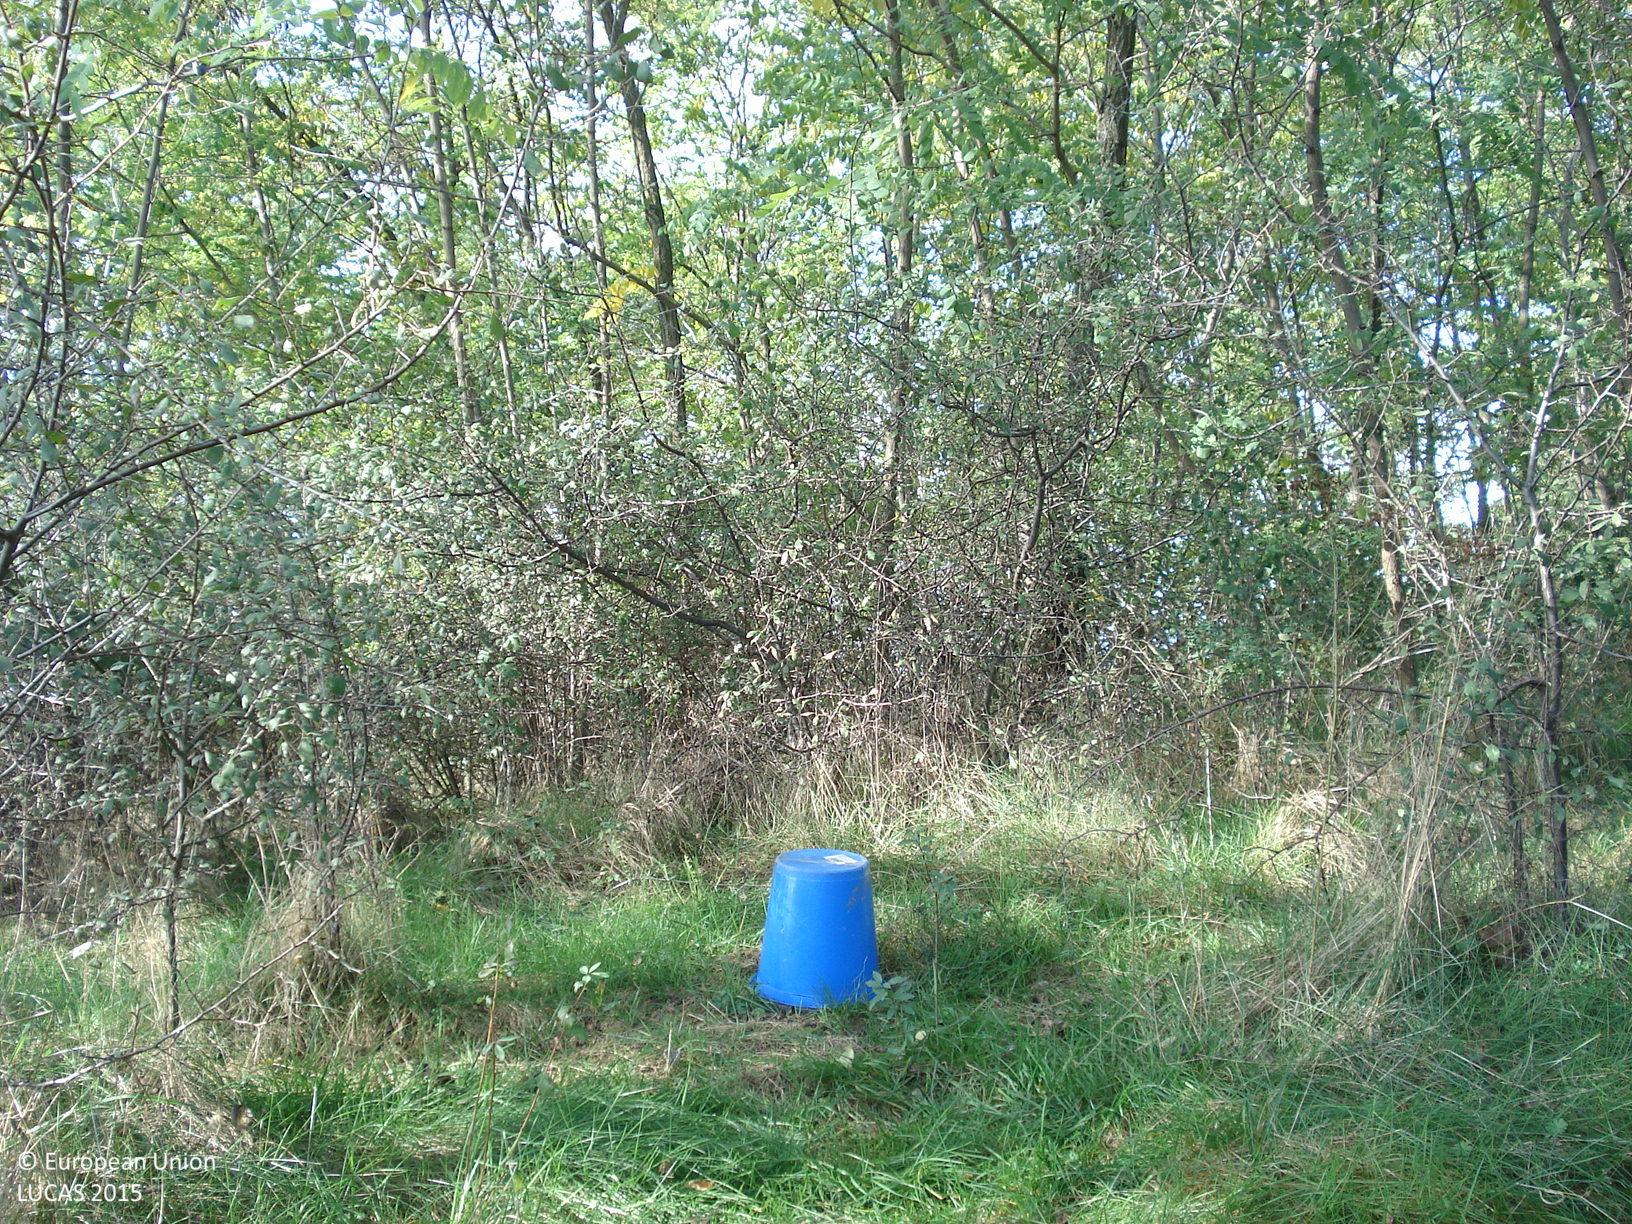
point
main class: Woodland
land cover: Broadleaved woodland
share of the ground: 50 - 75 %
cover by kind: broadleaved forest trees 60 %, herbaceous plants 25 %, shrubs 15 %
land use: Agriculture (excluding fallow land and kitchen gardens)
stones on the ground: < 10 %
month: October
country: BG
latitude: 42.9220
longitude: 26.0755
